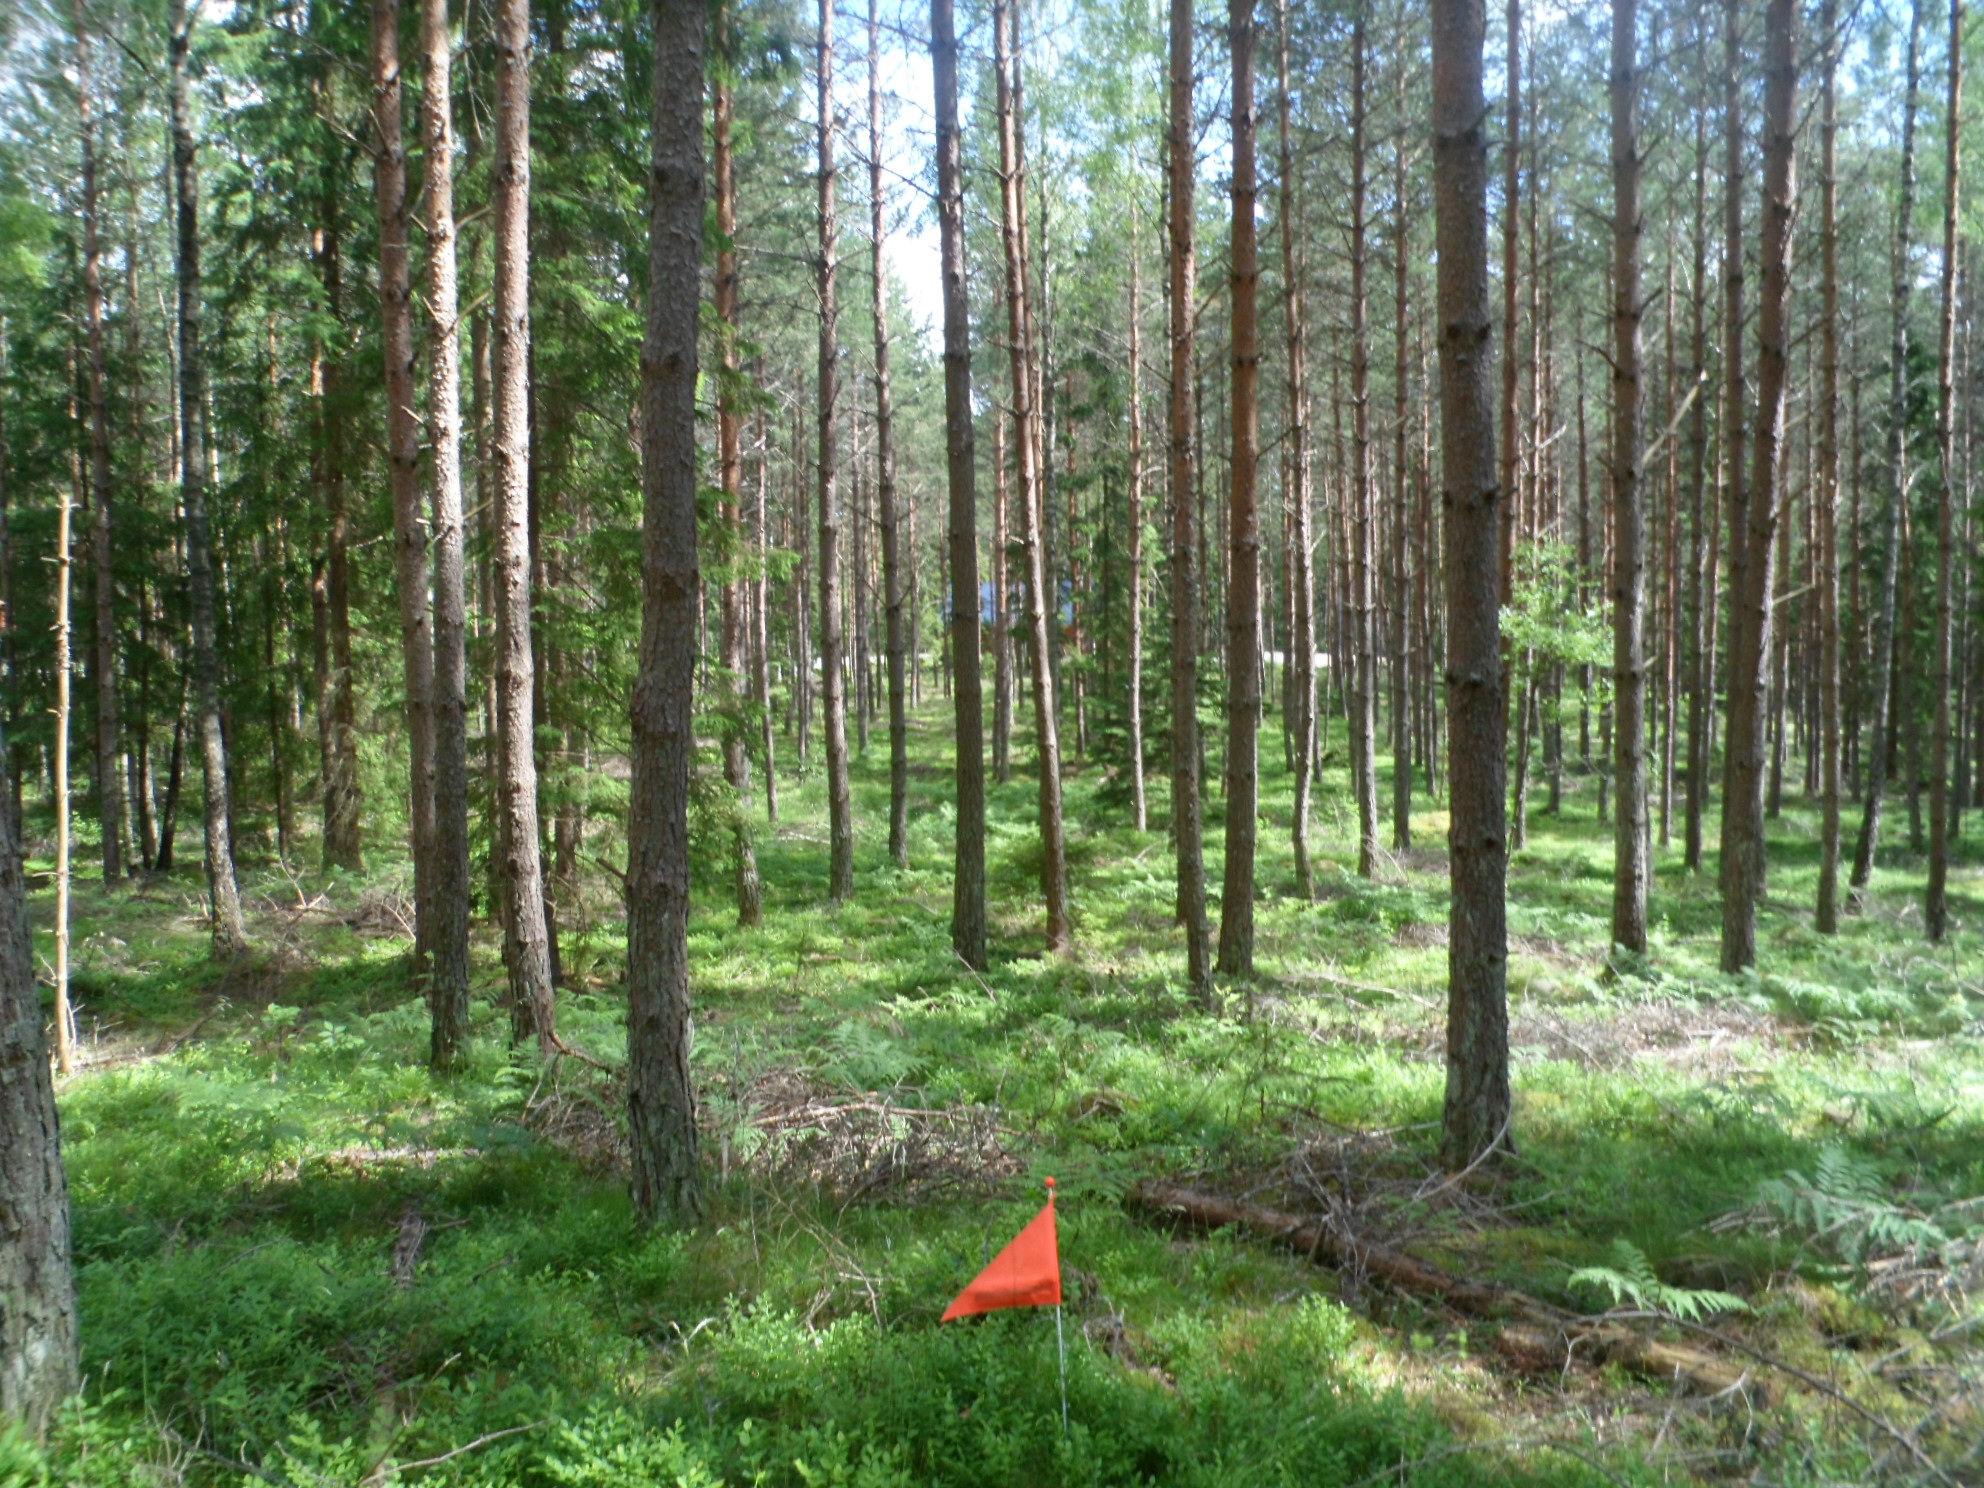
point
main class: Woodland
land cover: Pine dominated coniferous woodland
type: boreal forest
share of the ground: 50 - 75 %
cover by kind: coniferous forest trees 60 %, shrubs 20 %, lichens and mosses 15 %, herbaceous plants 5 %
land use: Forestry
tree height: > 5 m
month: June
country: SE
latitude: 57.1056
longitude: 14.8340
